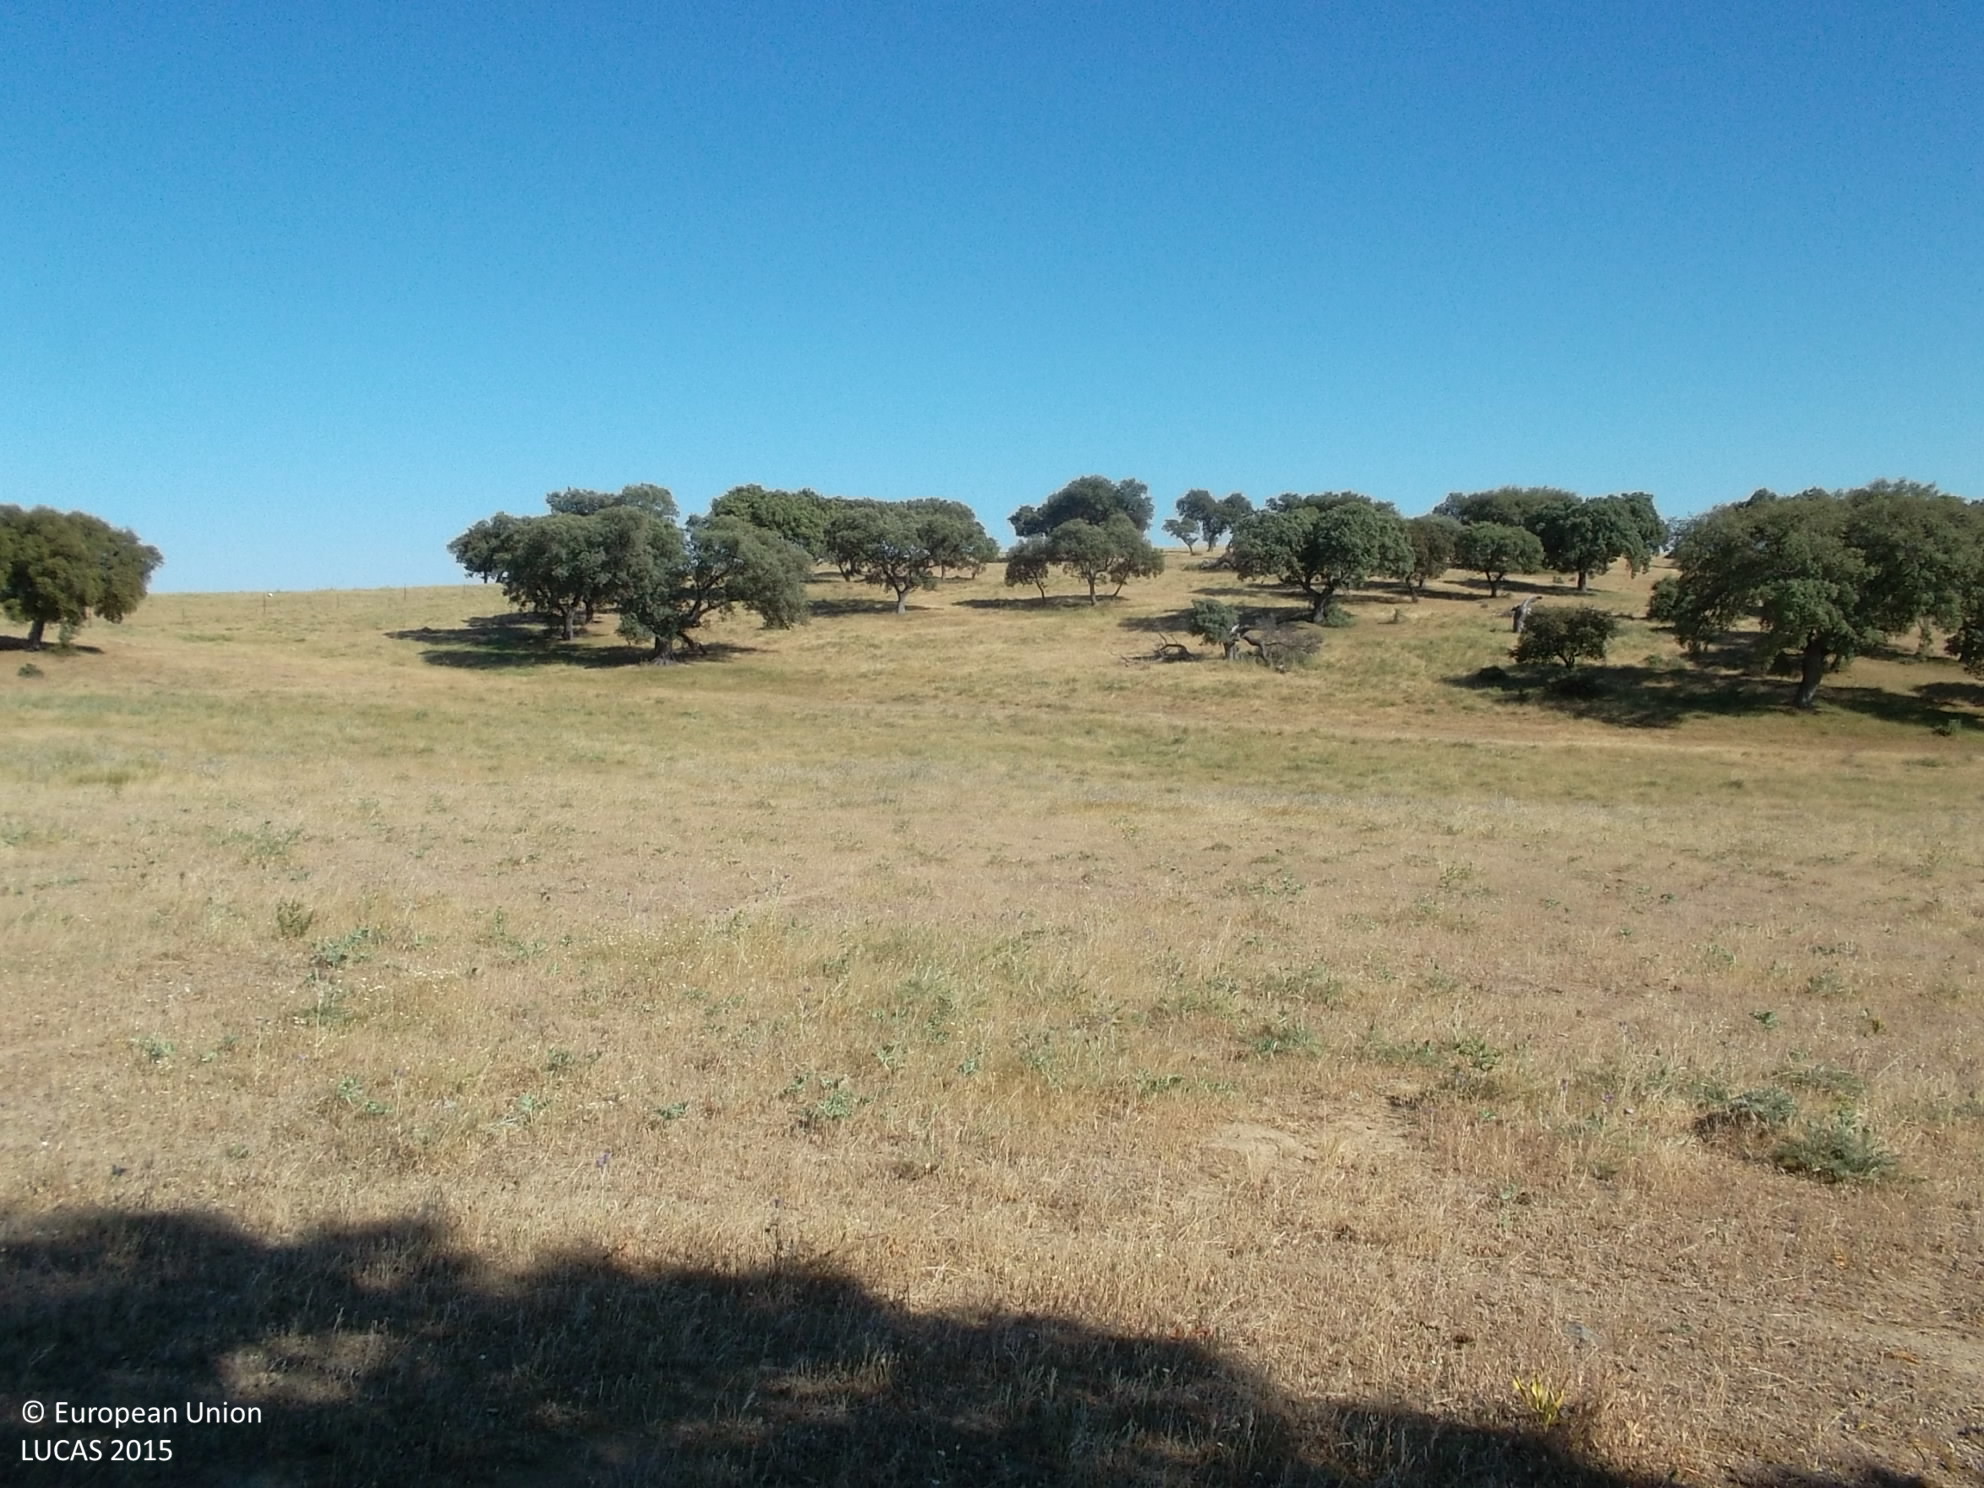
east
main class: Grassland
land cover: Grassland with sparse tree/shrub cover
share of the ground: 50 - 75 %
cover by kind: herbaceous plants 85 %, shrubs 10 %, broadleaved forest trees 5 %
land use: Agriculture (excluding fallow land and kitchen gardens)
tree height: > 5 m
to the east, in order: Grassland with sparse tree/shrub cover; Grassland without tree/shrub cover; Fences; Grassland with sparse tree/shrub cover; Tracks; Grassland with sparse tree/shrub cover
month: May
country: ES
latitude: 38.6455
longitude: -4.4181
